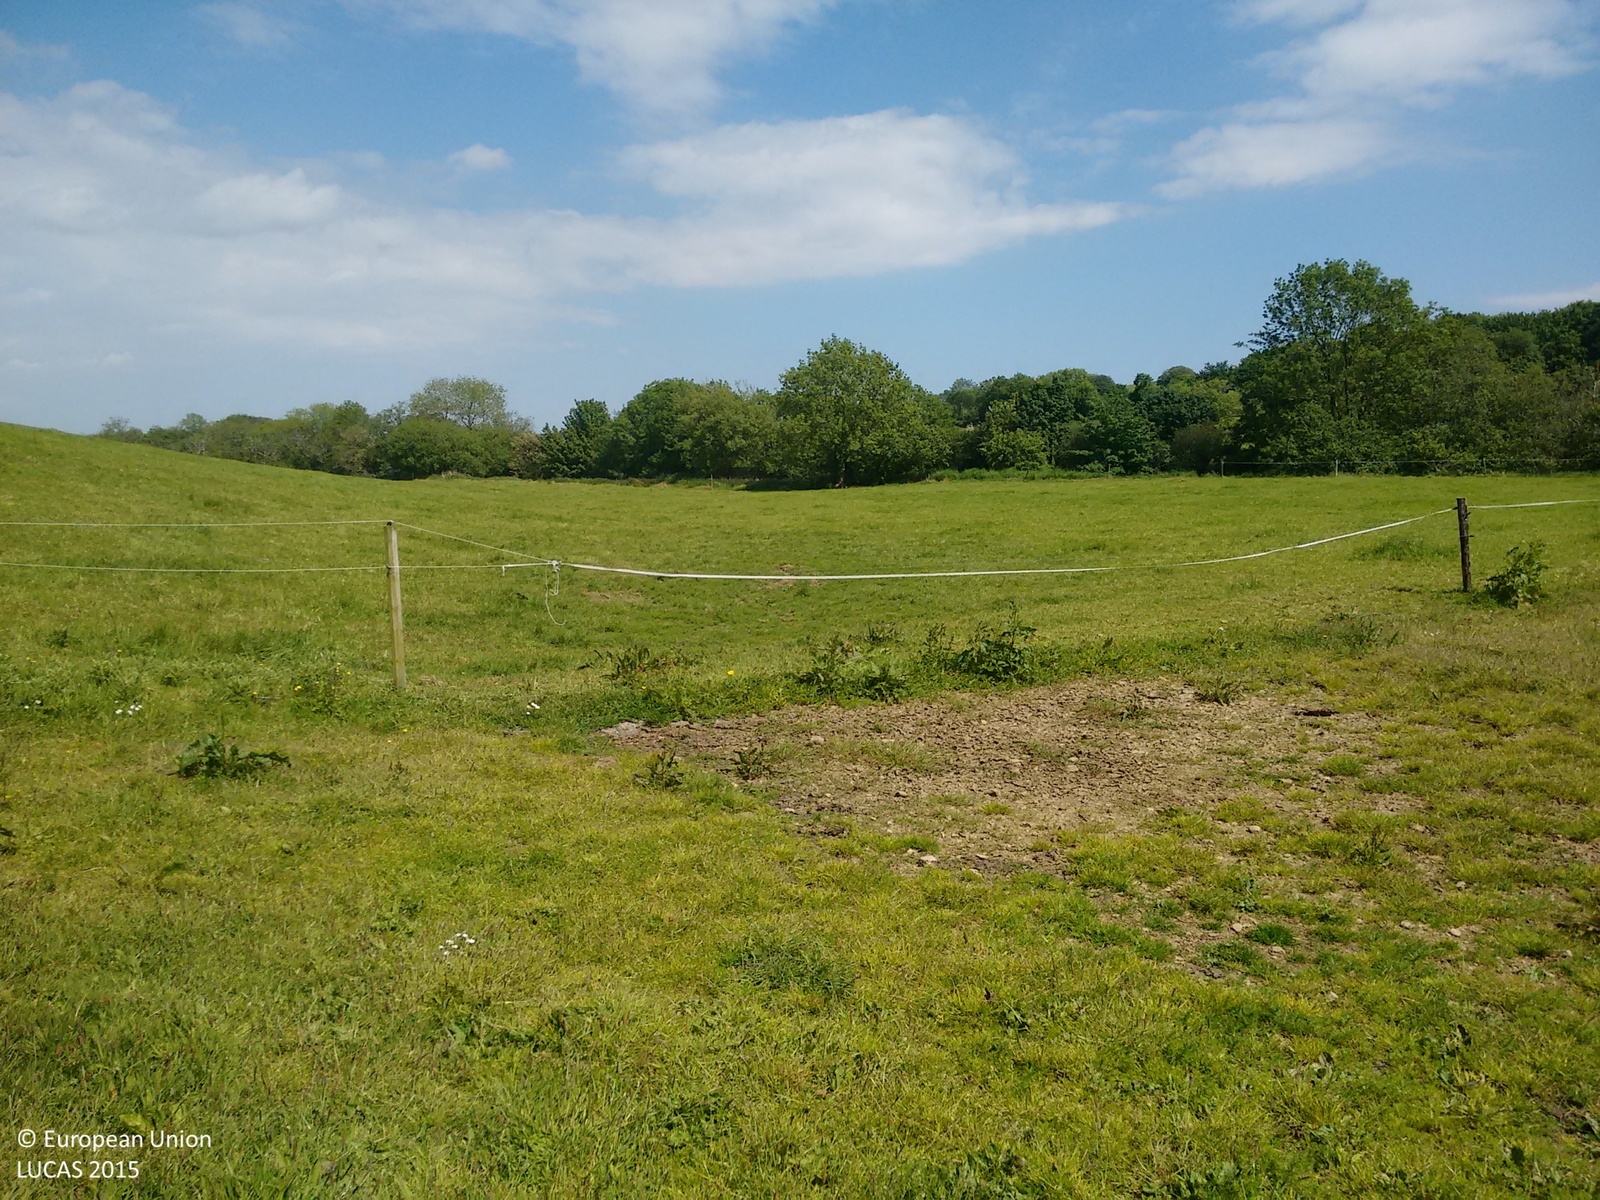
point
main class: Grassland
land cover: Grassland without tree/shrub cover
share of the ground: > 75 %
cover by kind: herbaceous plants 100 %
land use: Agriculture (excluding fallow land and kitchen gardens)
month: June
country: IE
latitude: 51.7354
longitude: -8.8431
